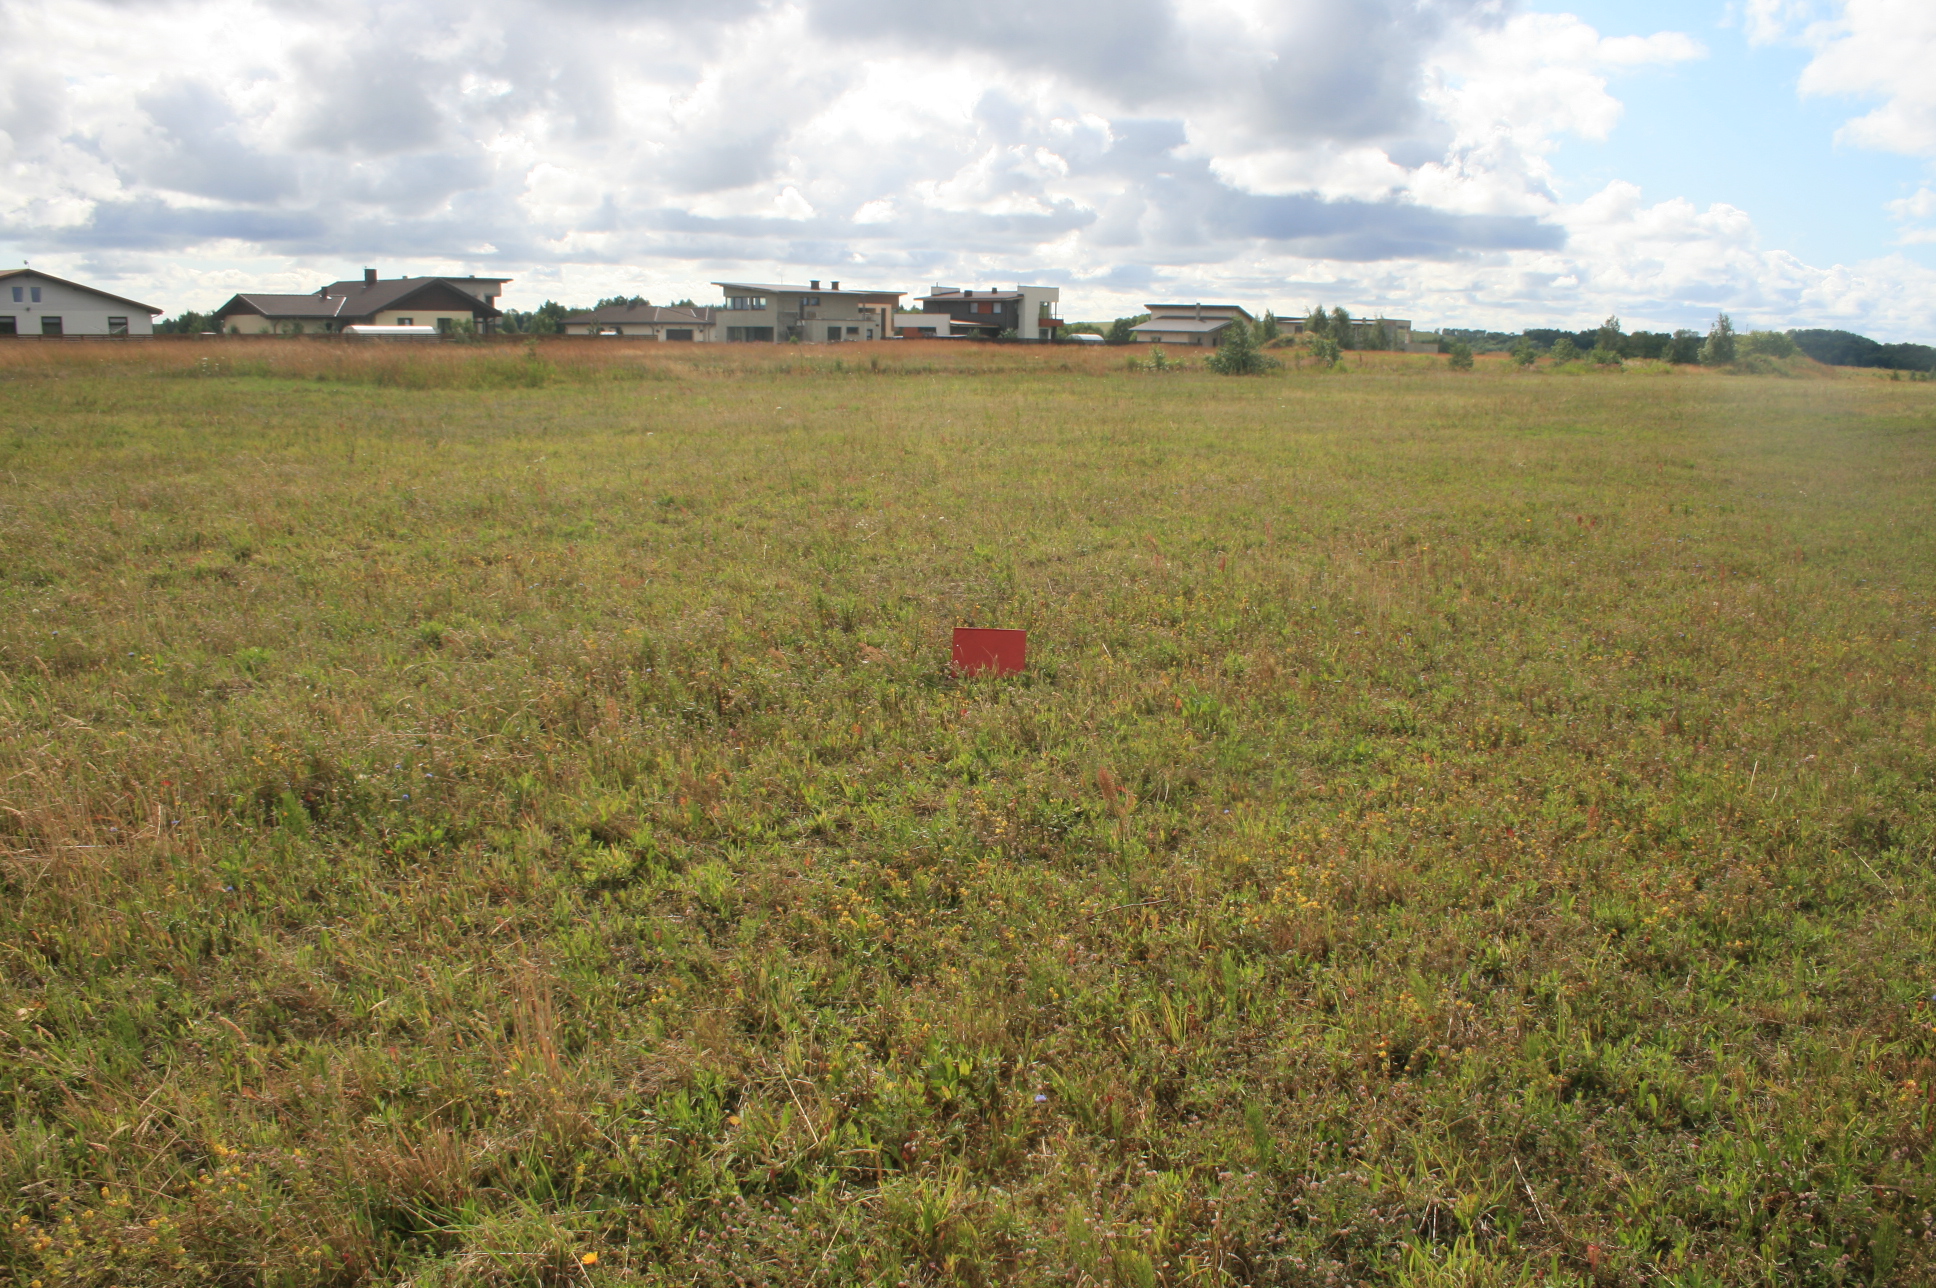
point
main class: Grassland
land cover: Grassland without tree/shrub cover
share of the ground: > 75 %
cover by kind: herbaceous plants 100 %
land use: Agriculture (excluding fallow land and kitchen gardens)
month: July
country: LT
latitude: 55.7877
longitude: 21.1878
